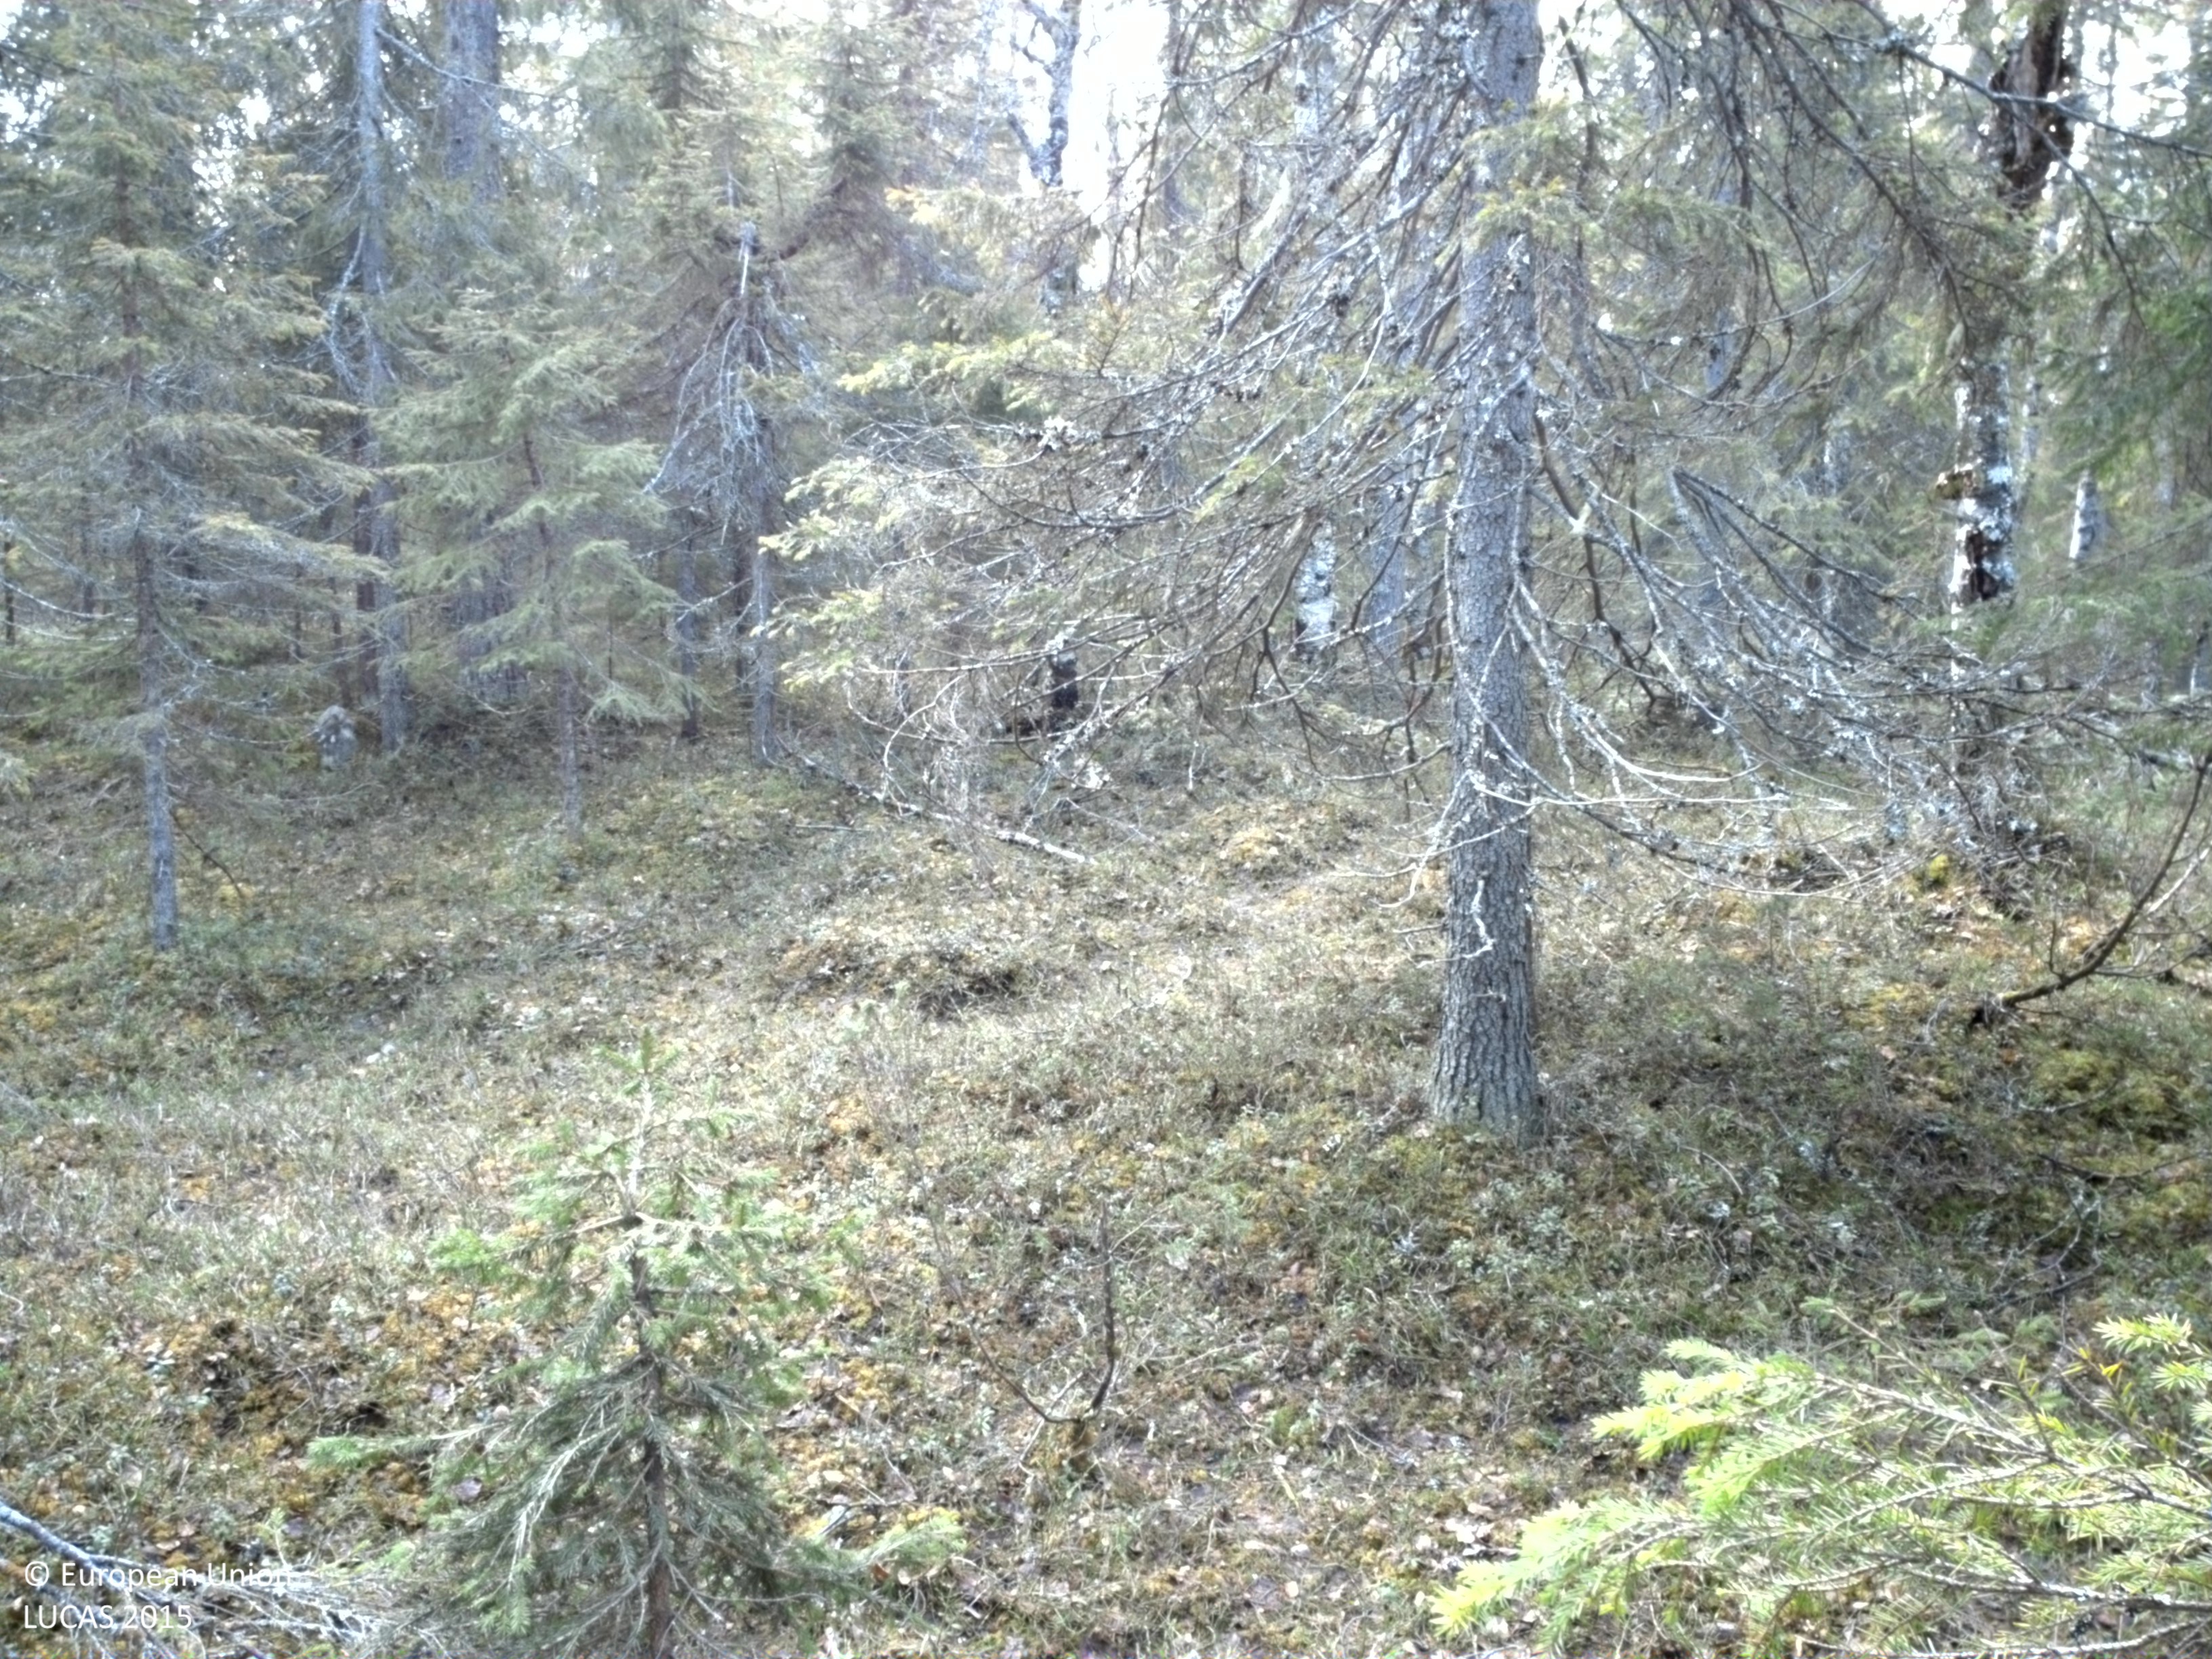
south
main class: Woodland
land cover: Spruce dominated coniferous woodland
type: boreal forest
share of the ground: > 75 %
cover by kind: coniferous forest trees 75 %, shrubs 15 %, broadleaved forest trees 10 %
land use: Forestry
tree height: > 5 m
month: June
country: SE
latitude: 66.4309
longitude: 23.2721
